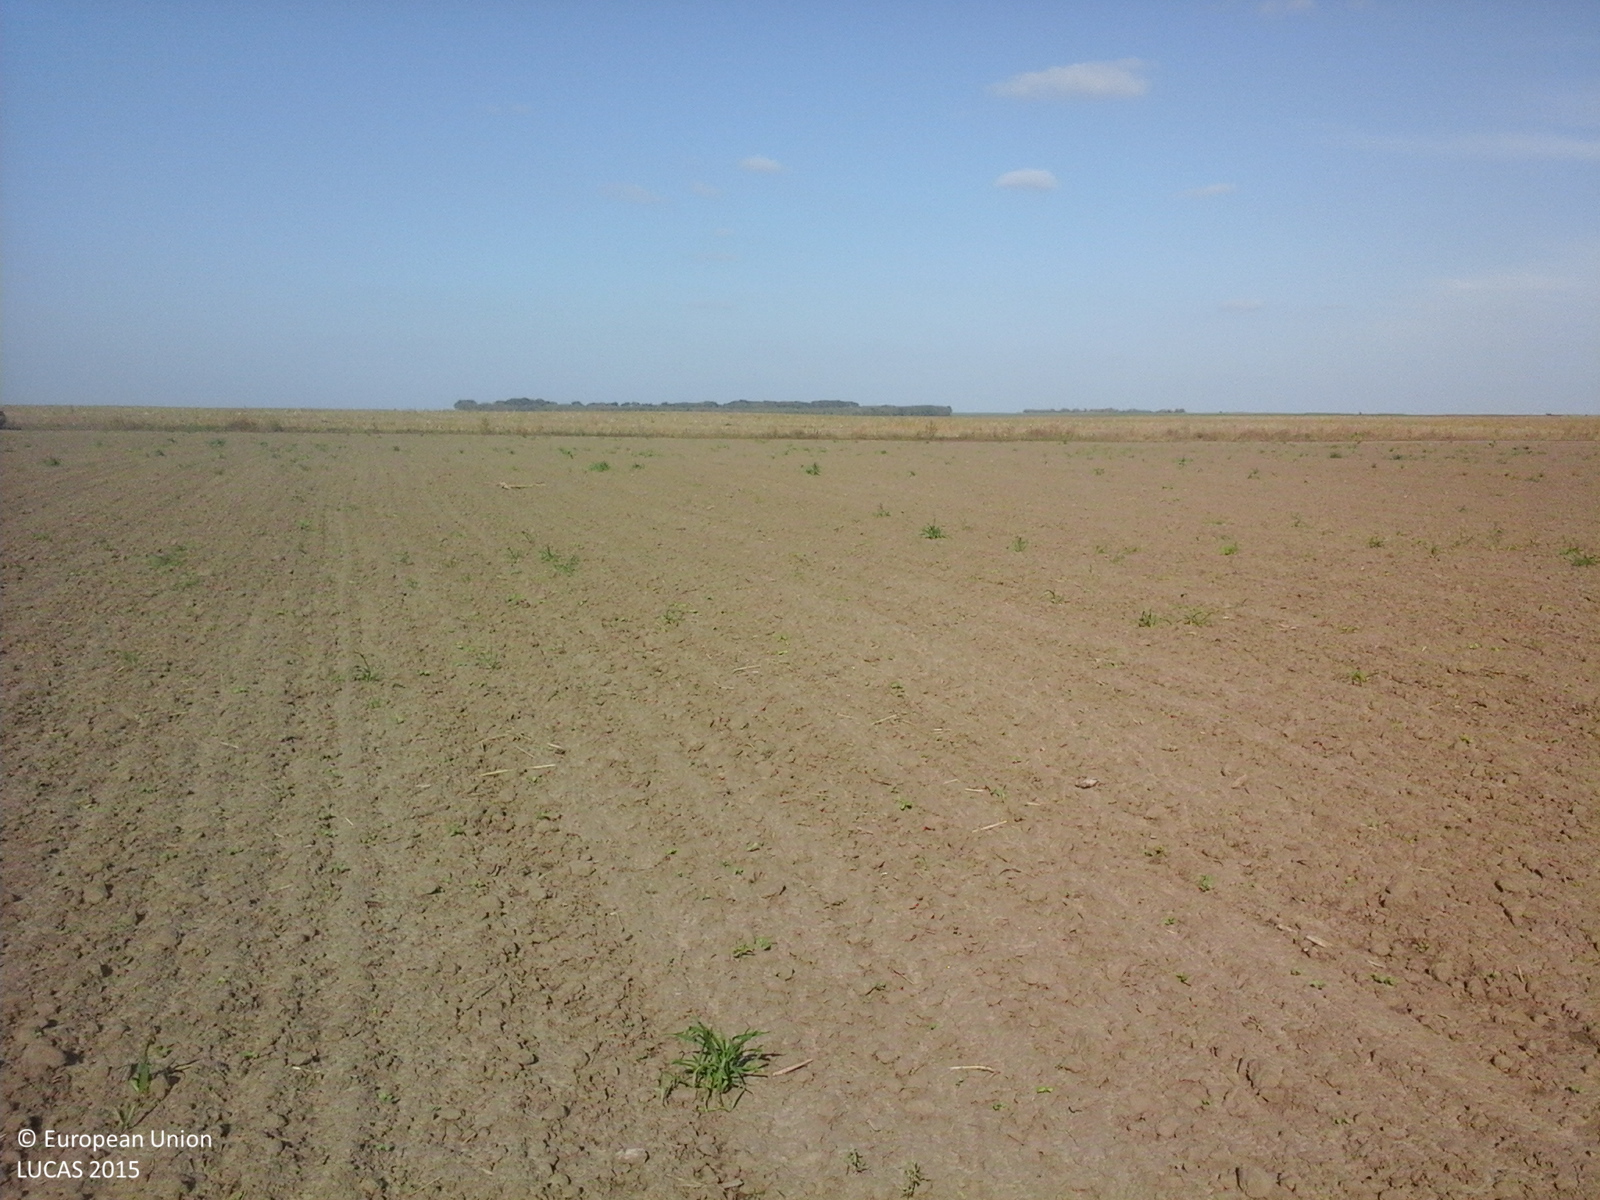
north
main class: Cropland
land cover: Maize
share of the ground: < 10 %
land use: Agriculture (excluding fallow land and kitchen gardens)
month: October
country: RO
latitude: 45.3362
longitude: 27.3883
